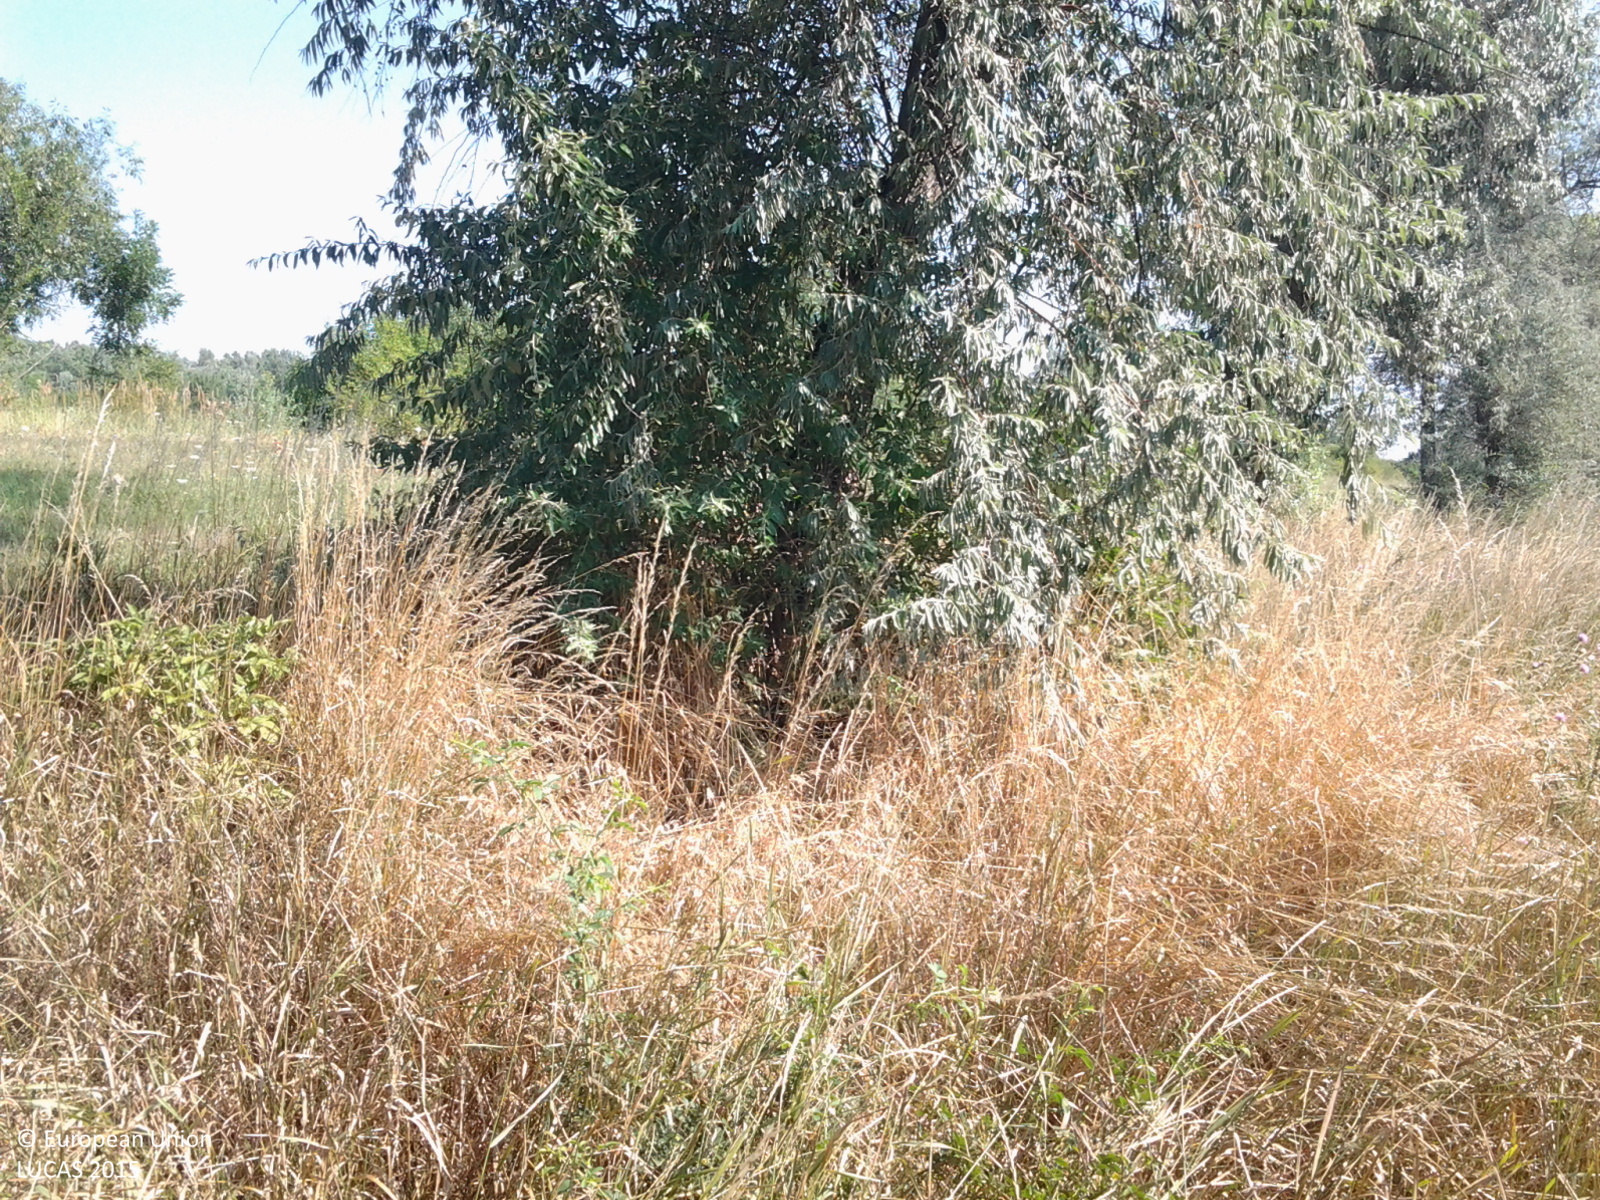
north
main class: Woodland
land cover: Broadleaved woodland
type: mire and swamp forests
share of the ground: 25 - 50 %
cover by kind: herbaceous plants 70 %, broadleaved forest trees 30 %
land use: Abandoned areas
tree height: < 5 m
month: July
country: HU
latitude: 47.3676
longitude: 20.5853
